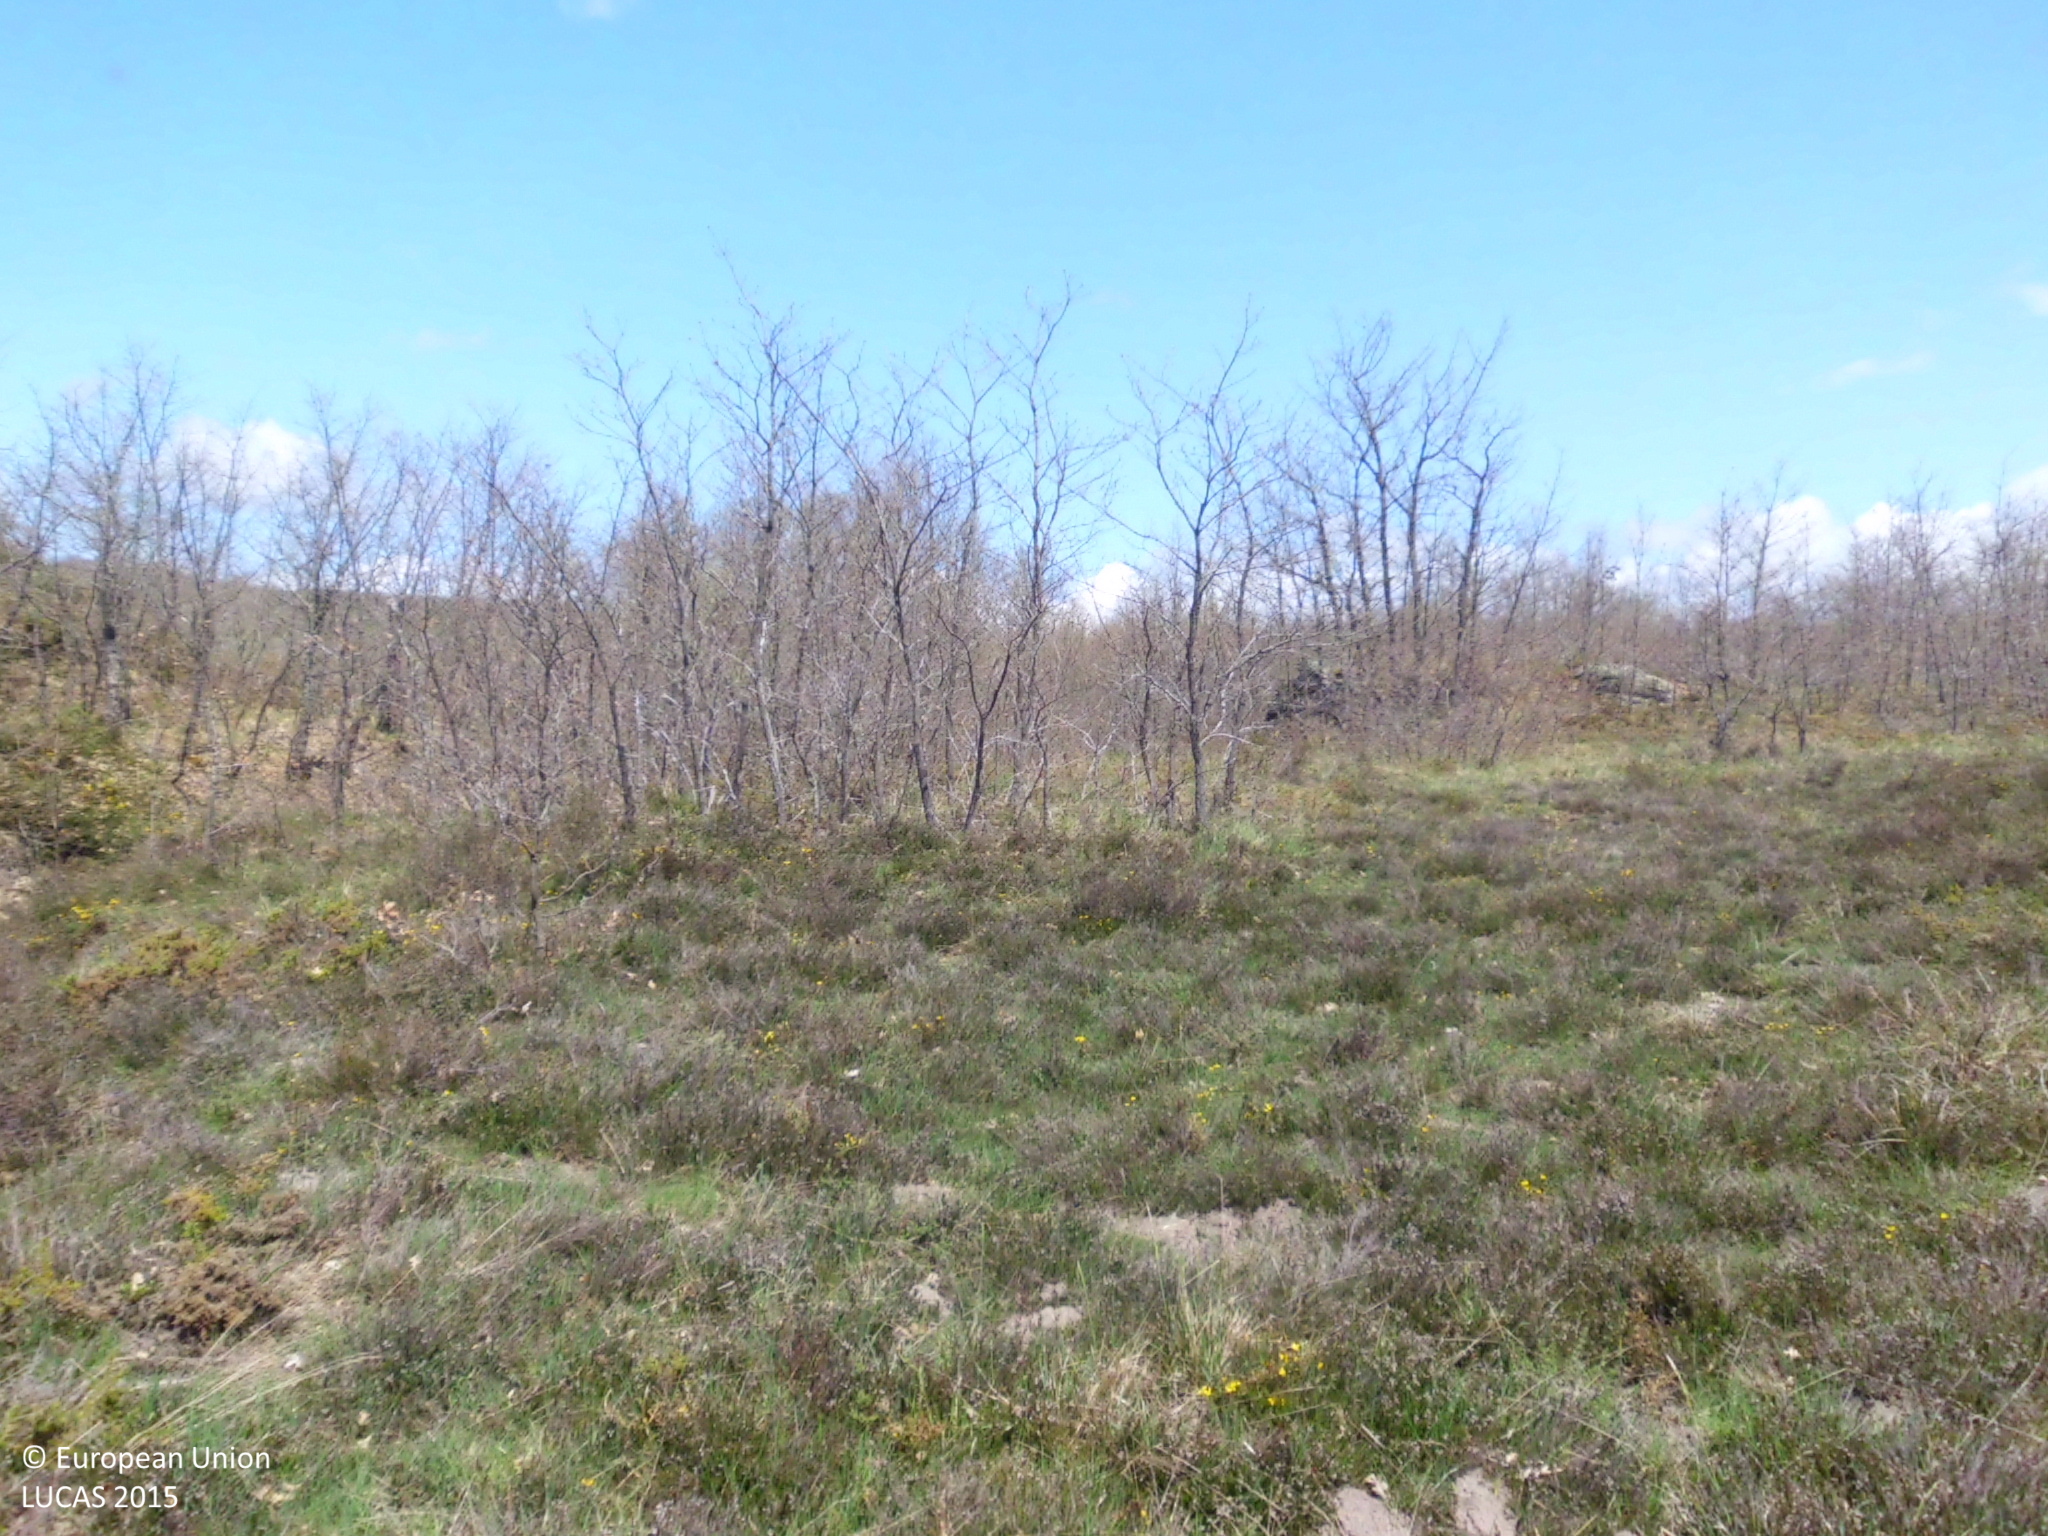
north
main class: Shrubland
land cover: Shrubland with sparse tree cover
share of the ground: 25 - 50 %
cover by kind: herbaceous plants 50 %, shrubs 45 %, broadleaved forest trees 5 %
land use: Semi-natural and natural areas not in use
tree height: < 5 m
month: May
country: ES
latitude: 42.8629
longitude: -3.8875
